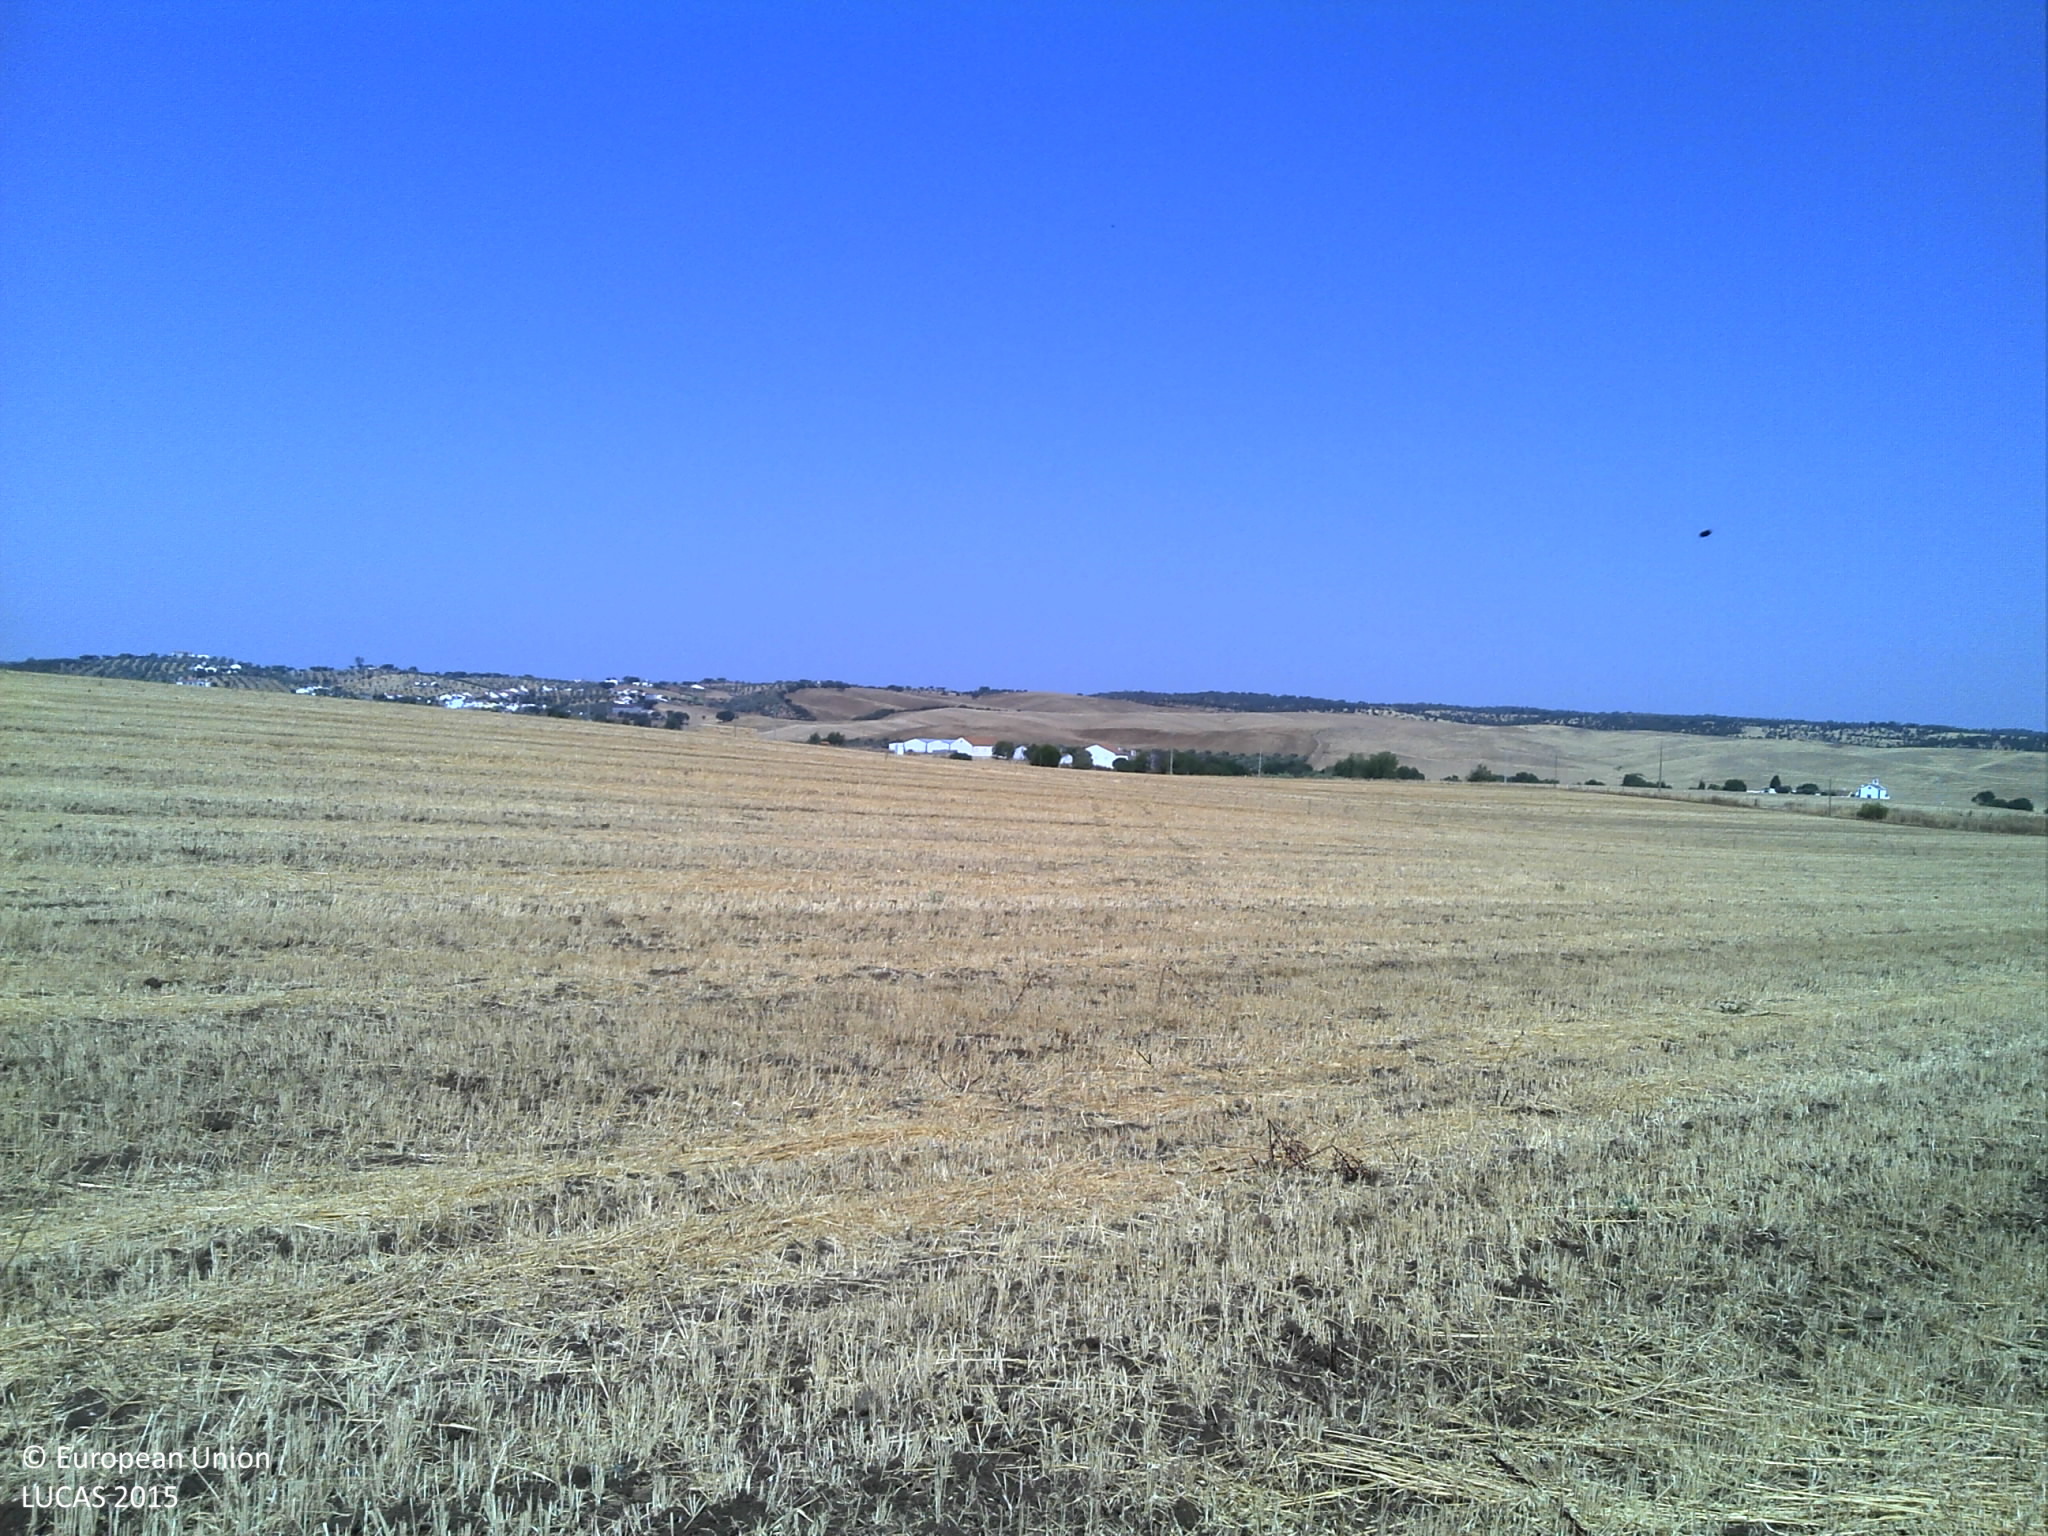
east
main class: Cropland
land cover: Oats
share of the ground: 10 - 25 %
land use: Agriculture (excluding fallow land and kitchen gardens)
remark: Harvested field
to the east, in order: Oats
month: July
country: PT
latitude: 38.5740
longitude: -7.6759
